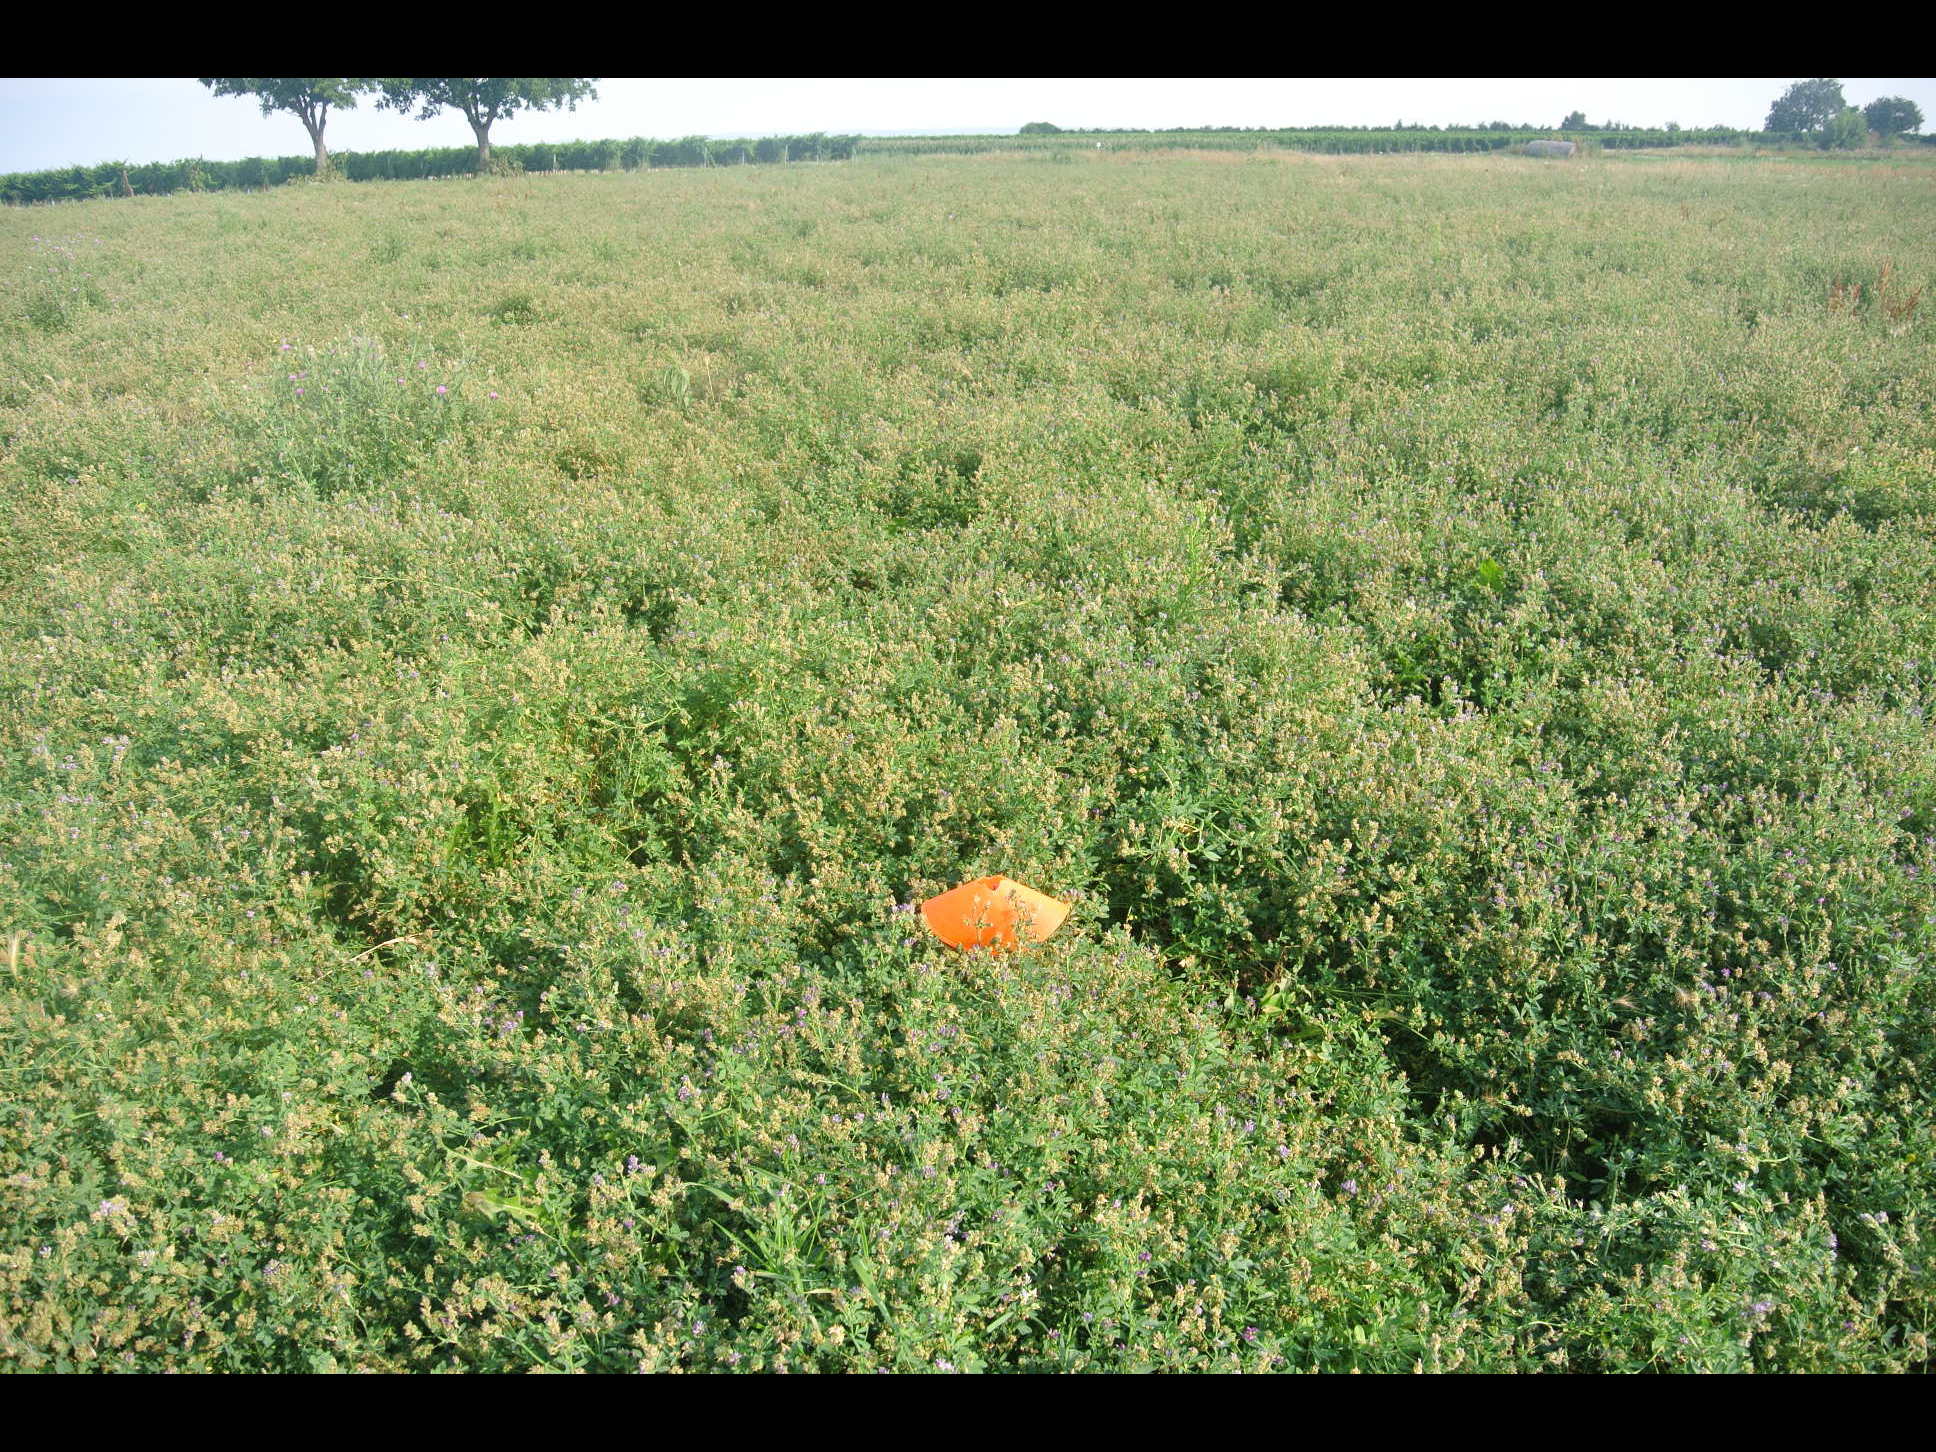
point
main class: Cropland
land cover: Clovers
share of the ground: > 75 %
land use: Agriculture (excluding fallow land and kitchen gardens)
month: July
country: AT
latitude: 47.7772
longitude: 16.8253
